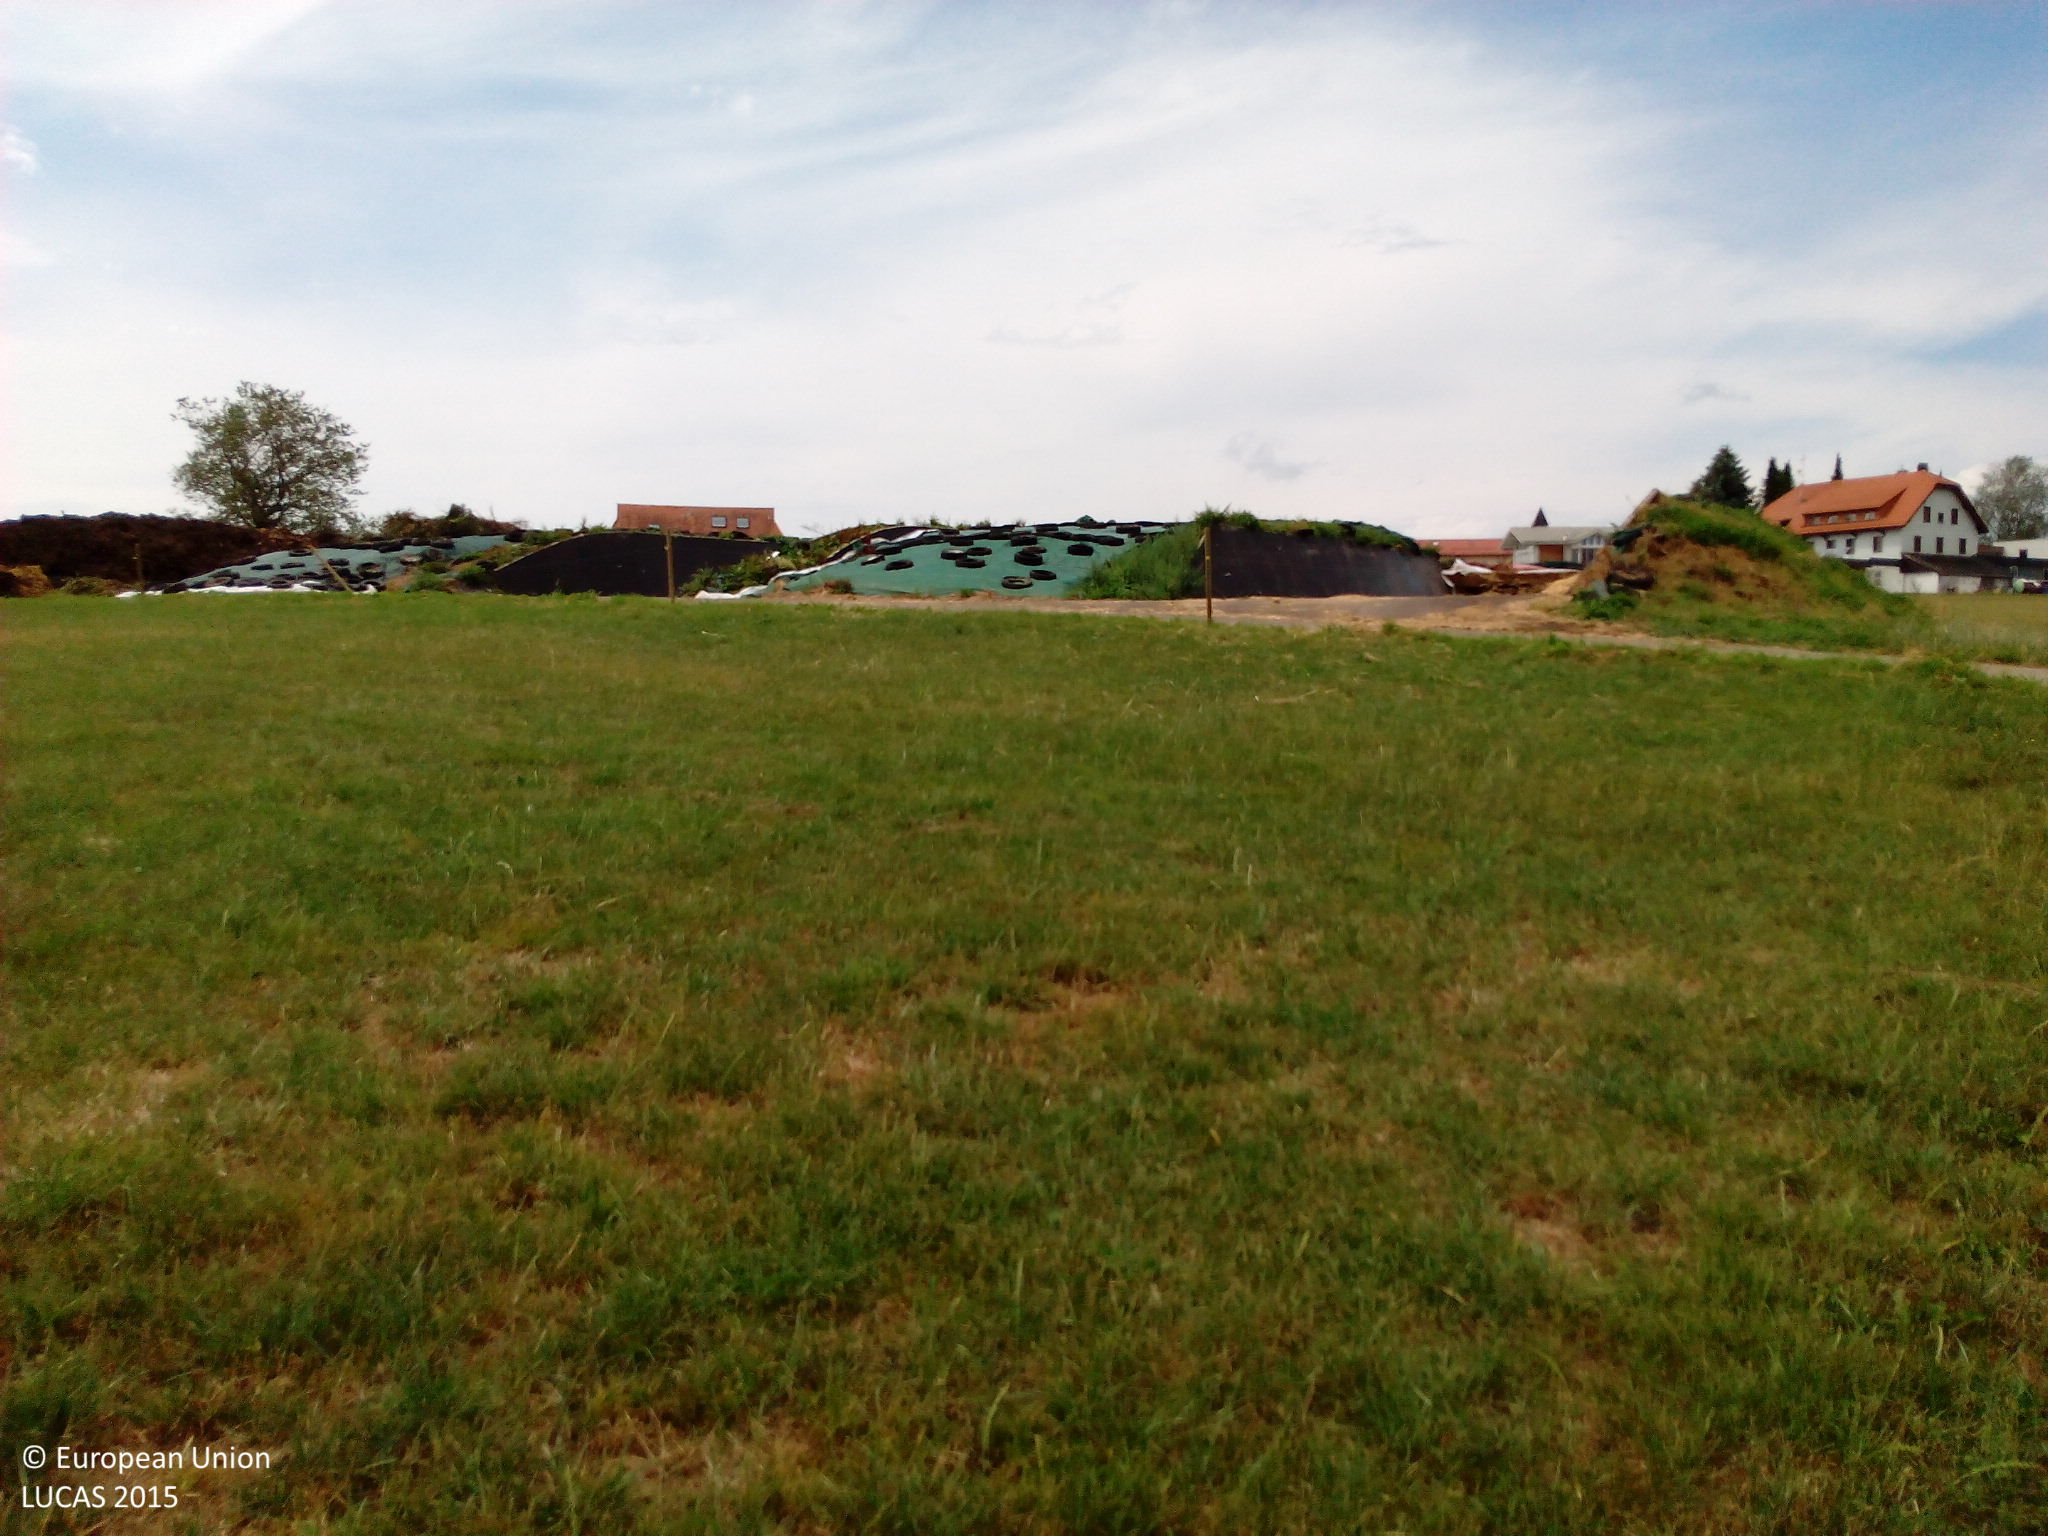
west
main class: Grassland
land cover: Grassland without tree/shrub cover
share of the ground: > 75 %
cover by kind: herbaceous plants 100 %
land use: Agriculture (excluding fallow land and kitchen gardens)
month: August
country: DE
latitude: 47.7040
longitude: 8.1489
